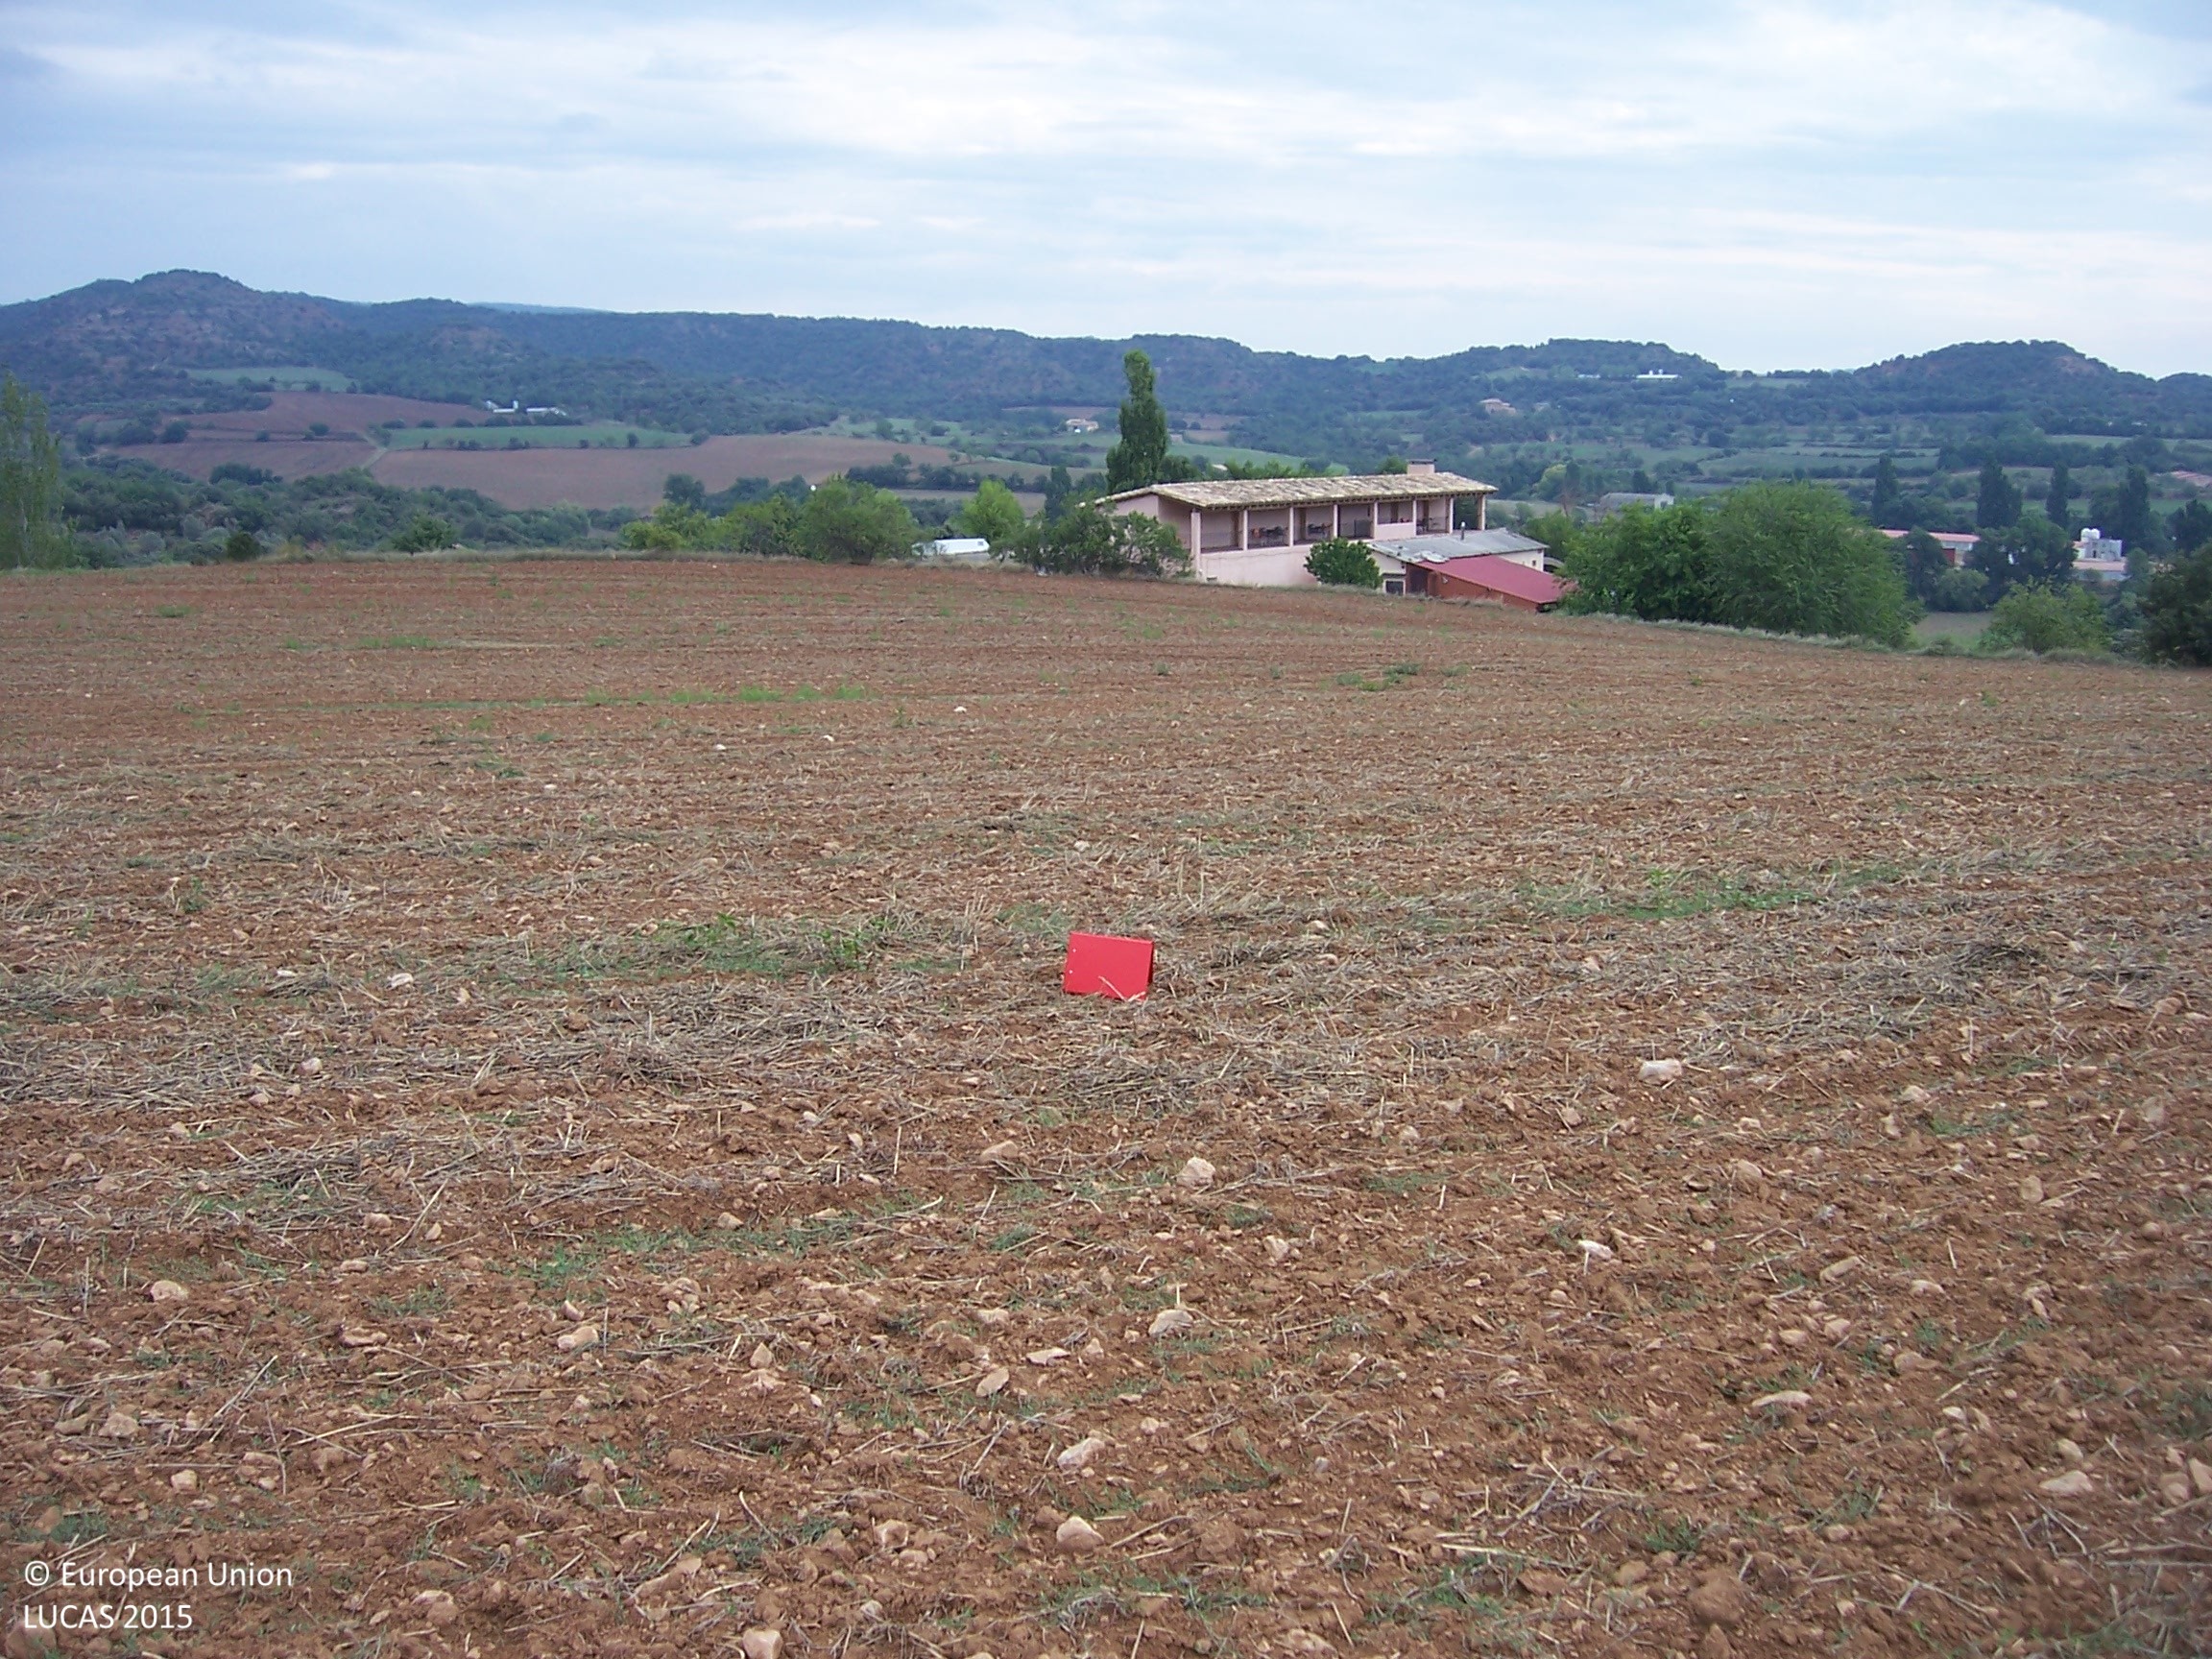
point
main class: Grassland
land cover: Spontaneously vegetated surfaces
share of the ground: > 75 %
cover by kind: unconsolidated bare surface 80 %, herbaceous plants 20 %
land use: Fallow land
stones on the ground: 10 - 25 %
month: August
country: ES
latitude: 42.1147
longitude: 0.4889
